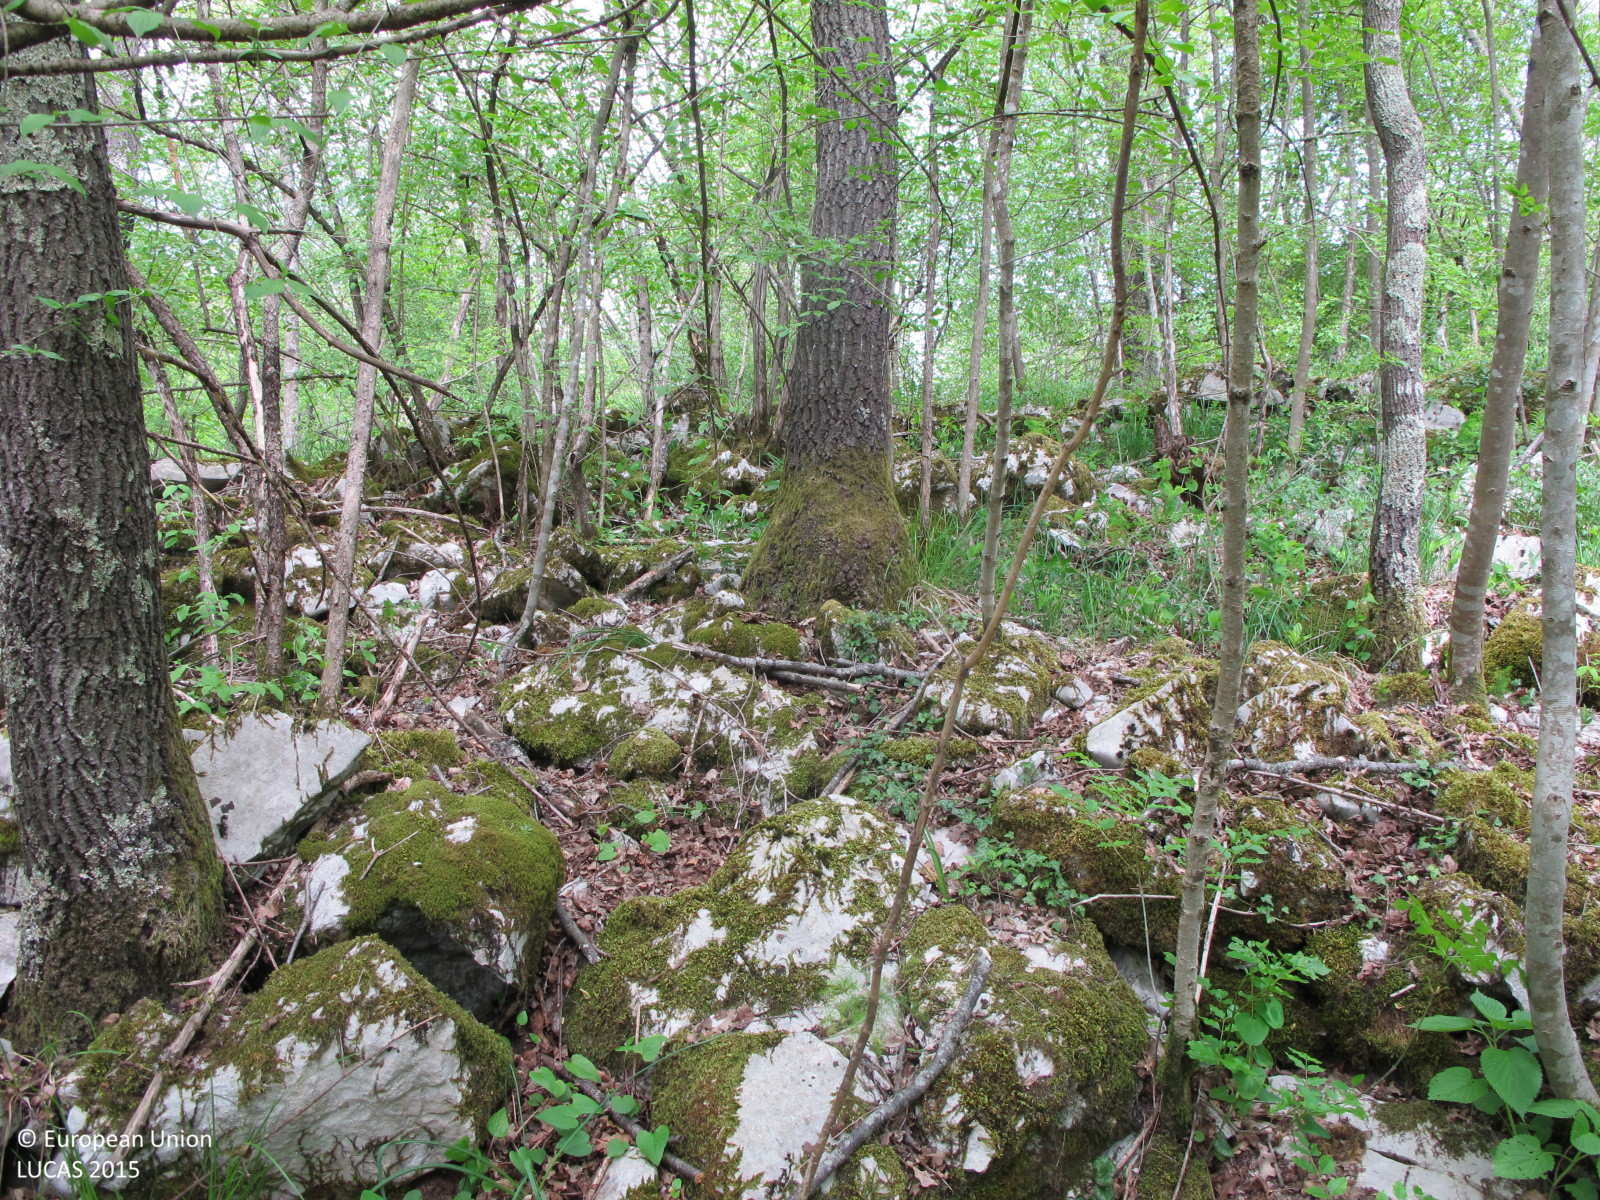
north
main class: Woodland
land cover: Broadleaved woodland
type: thermophilous deciduous forest
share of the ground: > 75 %
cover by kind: broadleaved forest trees 75 %, herbaceous plants 10 %, shrubs 5 %, consolidated bare surface 5 %
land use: Forestry
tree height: > 5 m
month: May
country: HR
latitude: 45.4178
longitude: 14.2761
